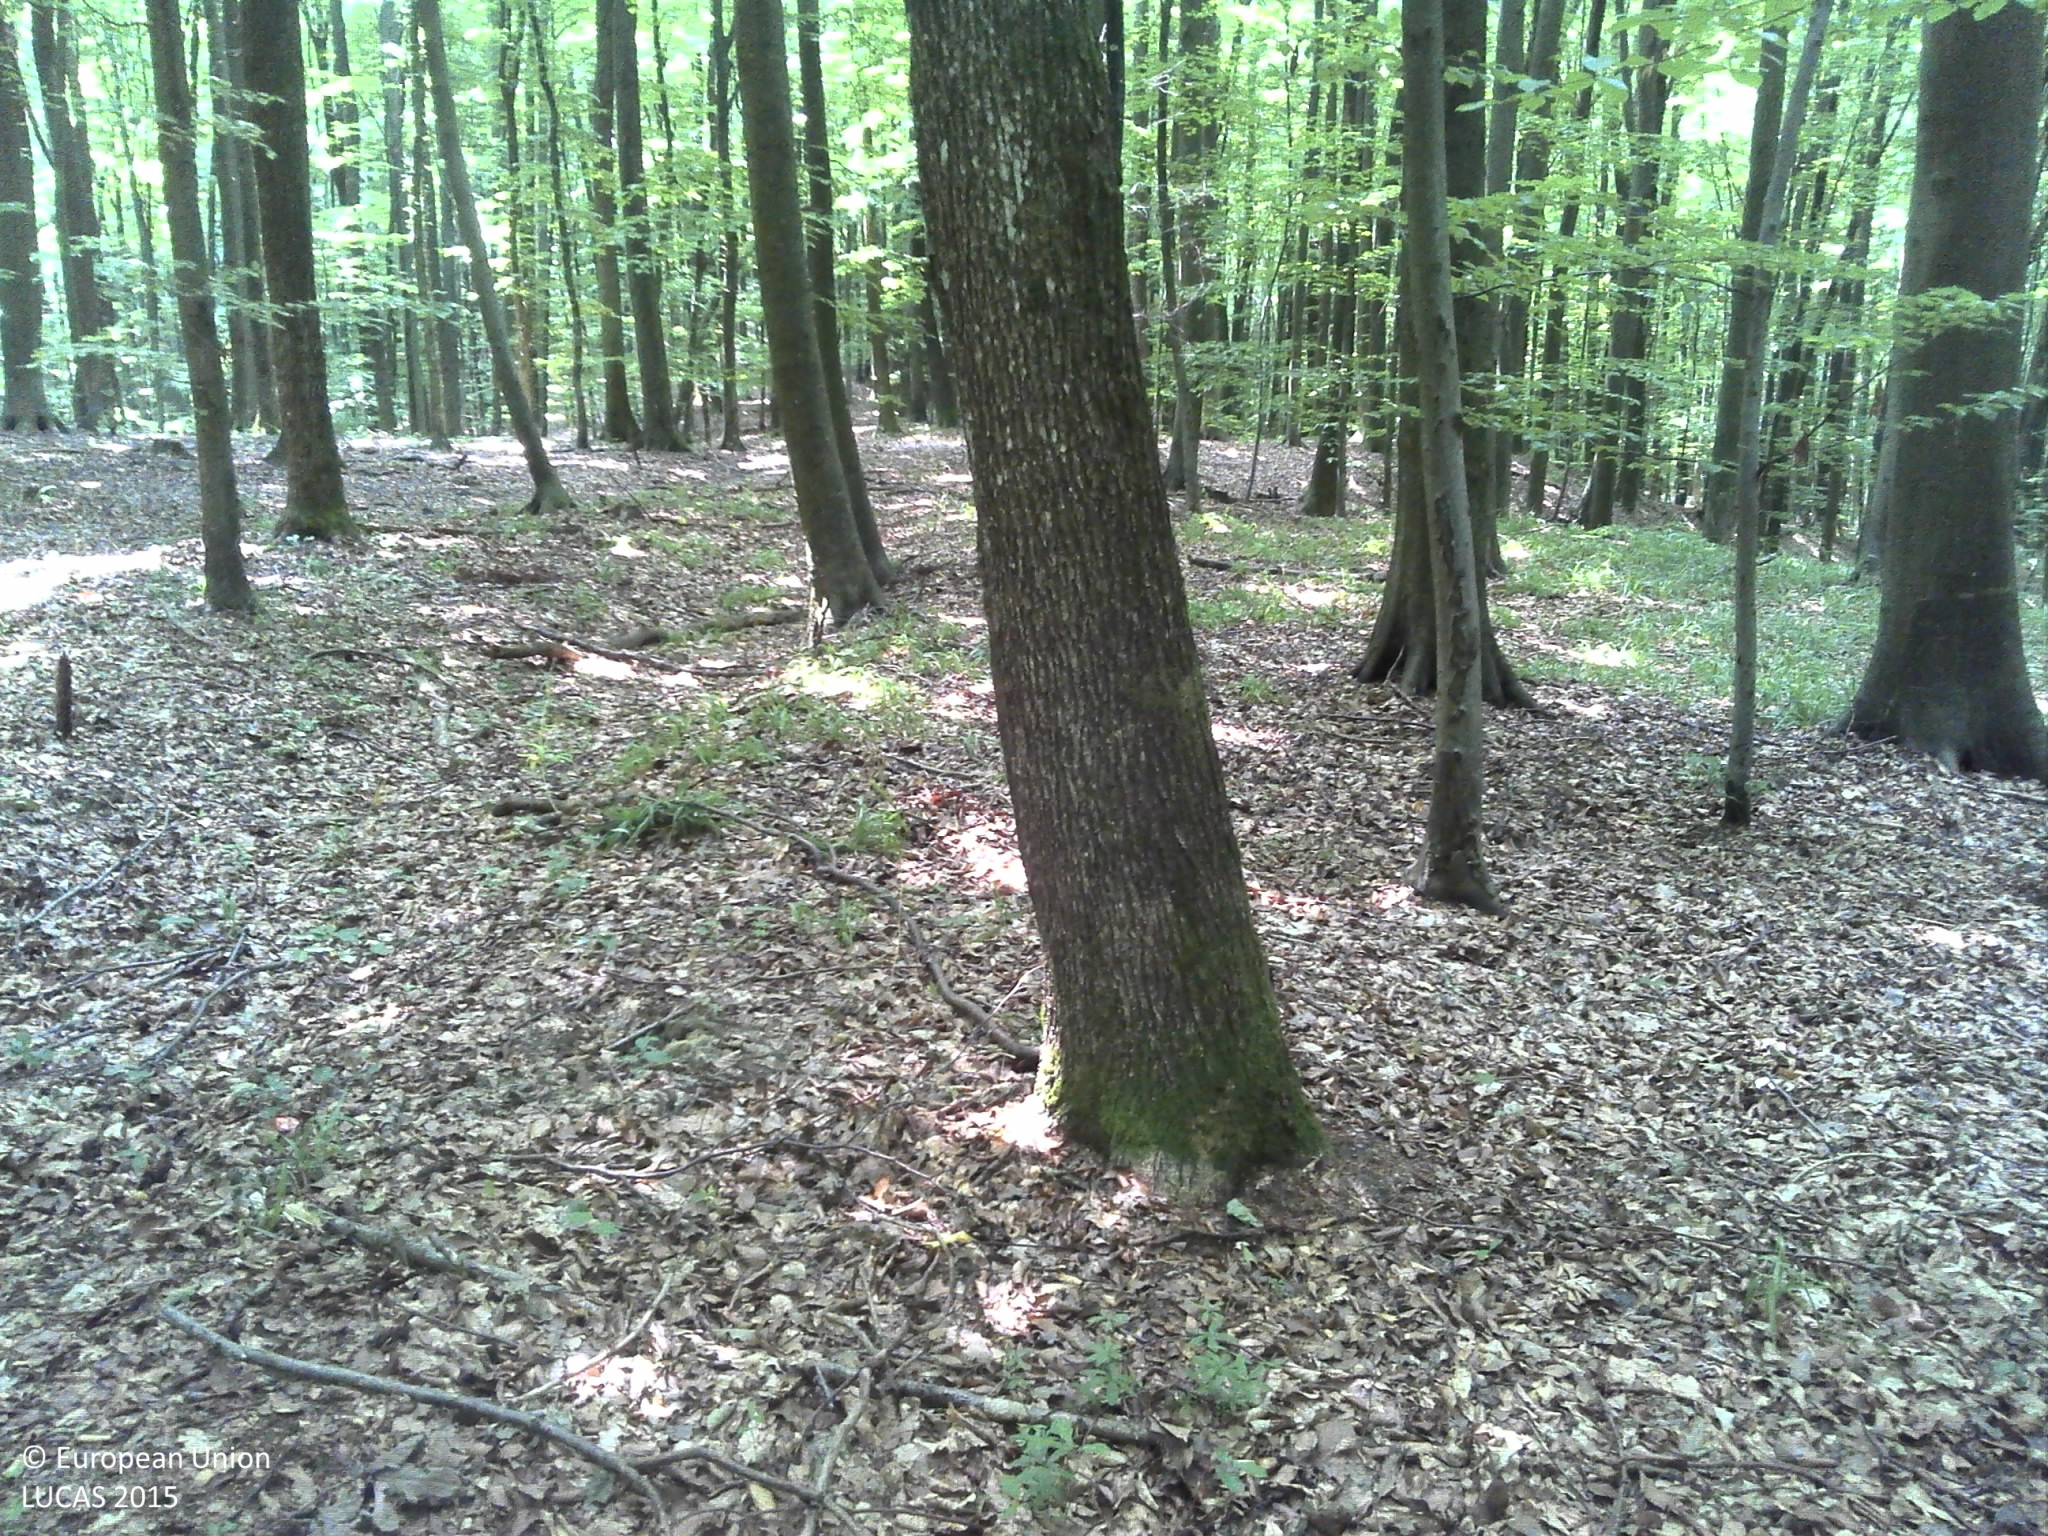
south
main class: Woodland
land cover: Broadleaved woodland
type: acidophilous oak and oak-birch forest
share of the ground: > 75 %
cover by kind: broadleaved forest trees 95 %, herbaceous plants 5 %
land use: Forestry
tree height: > 5 m
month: July
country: HR
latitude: 46.0762
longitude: 16.8670
